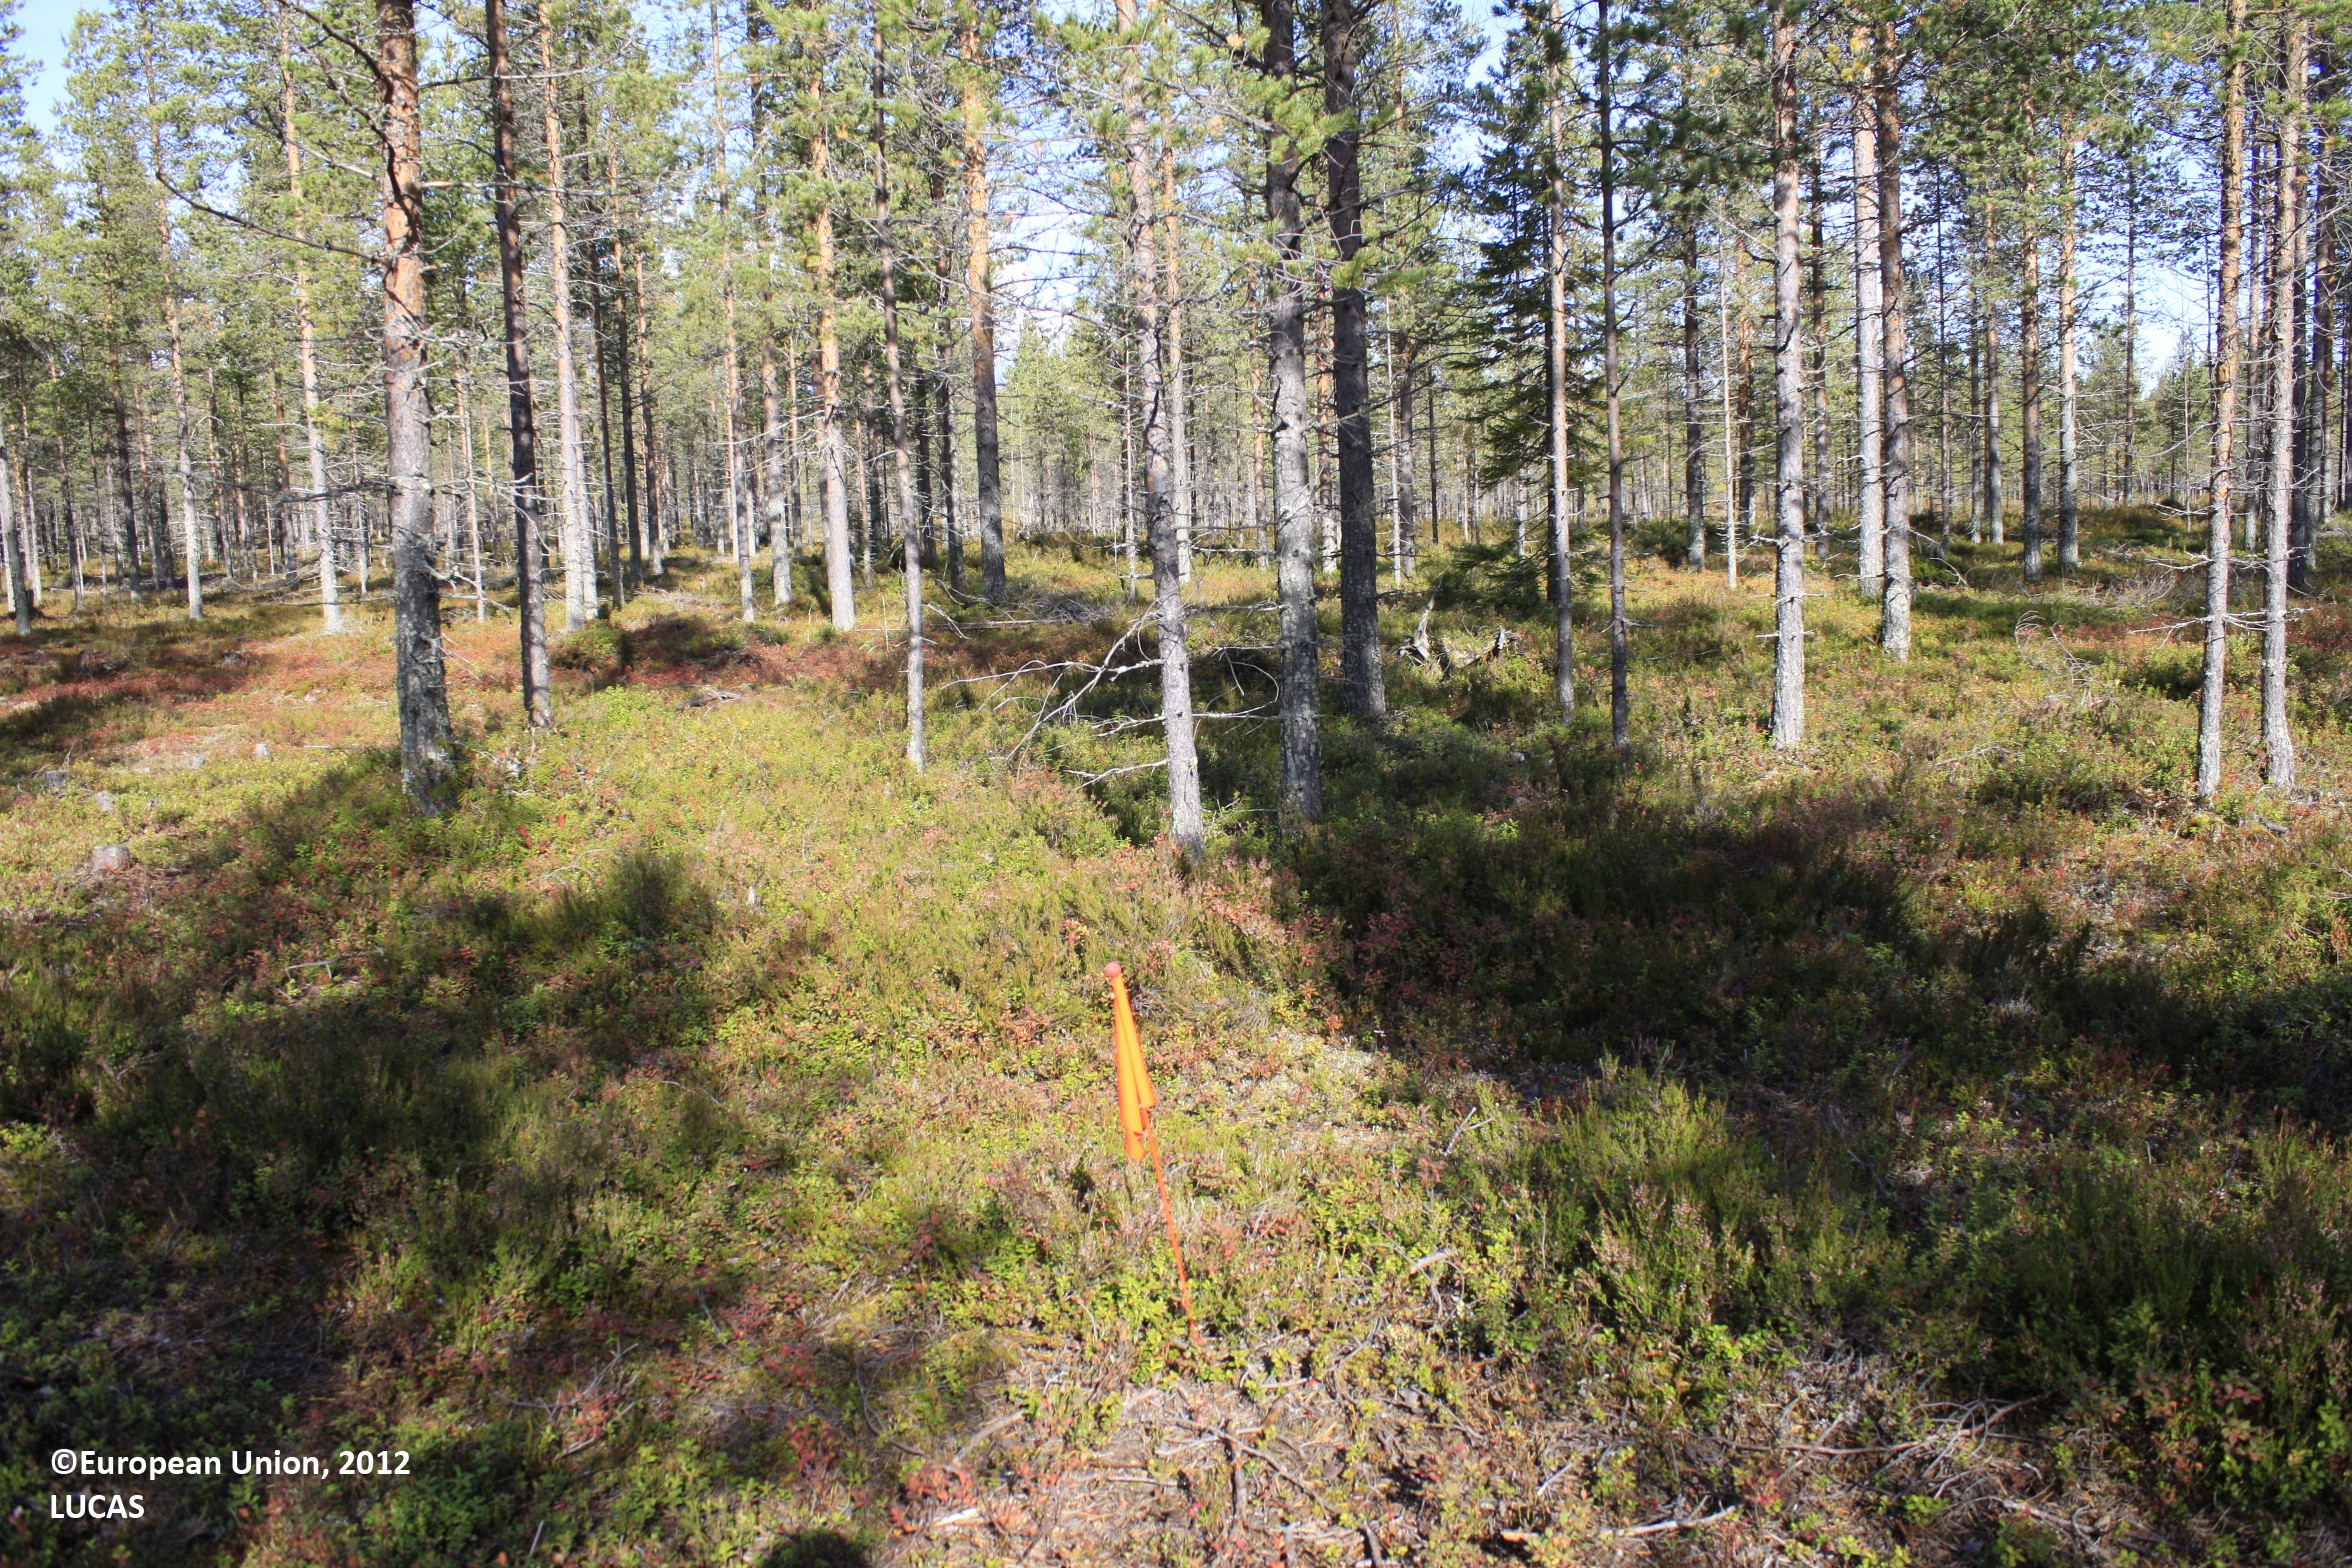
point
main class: Woodland
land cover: Pine dominated coniferous woodland
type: boreal forest
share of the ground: < 10 %
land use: Forestry
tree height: > 5 m
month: September
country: FI
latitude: 65.5018
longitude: 26.9497
